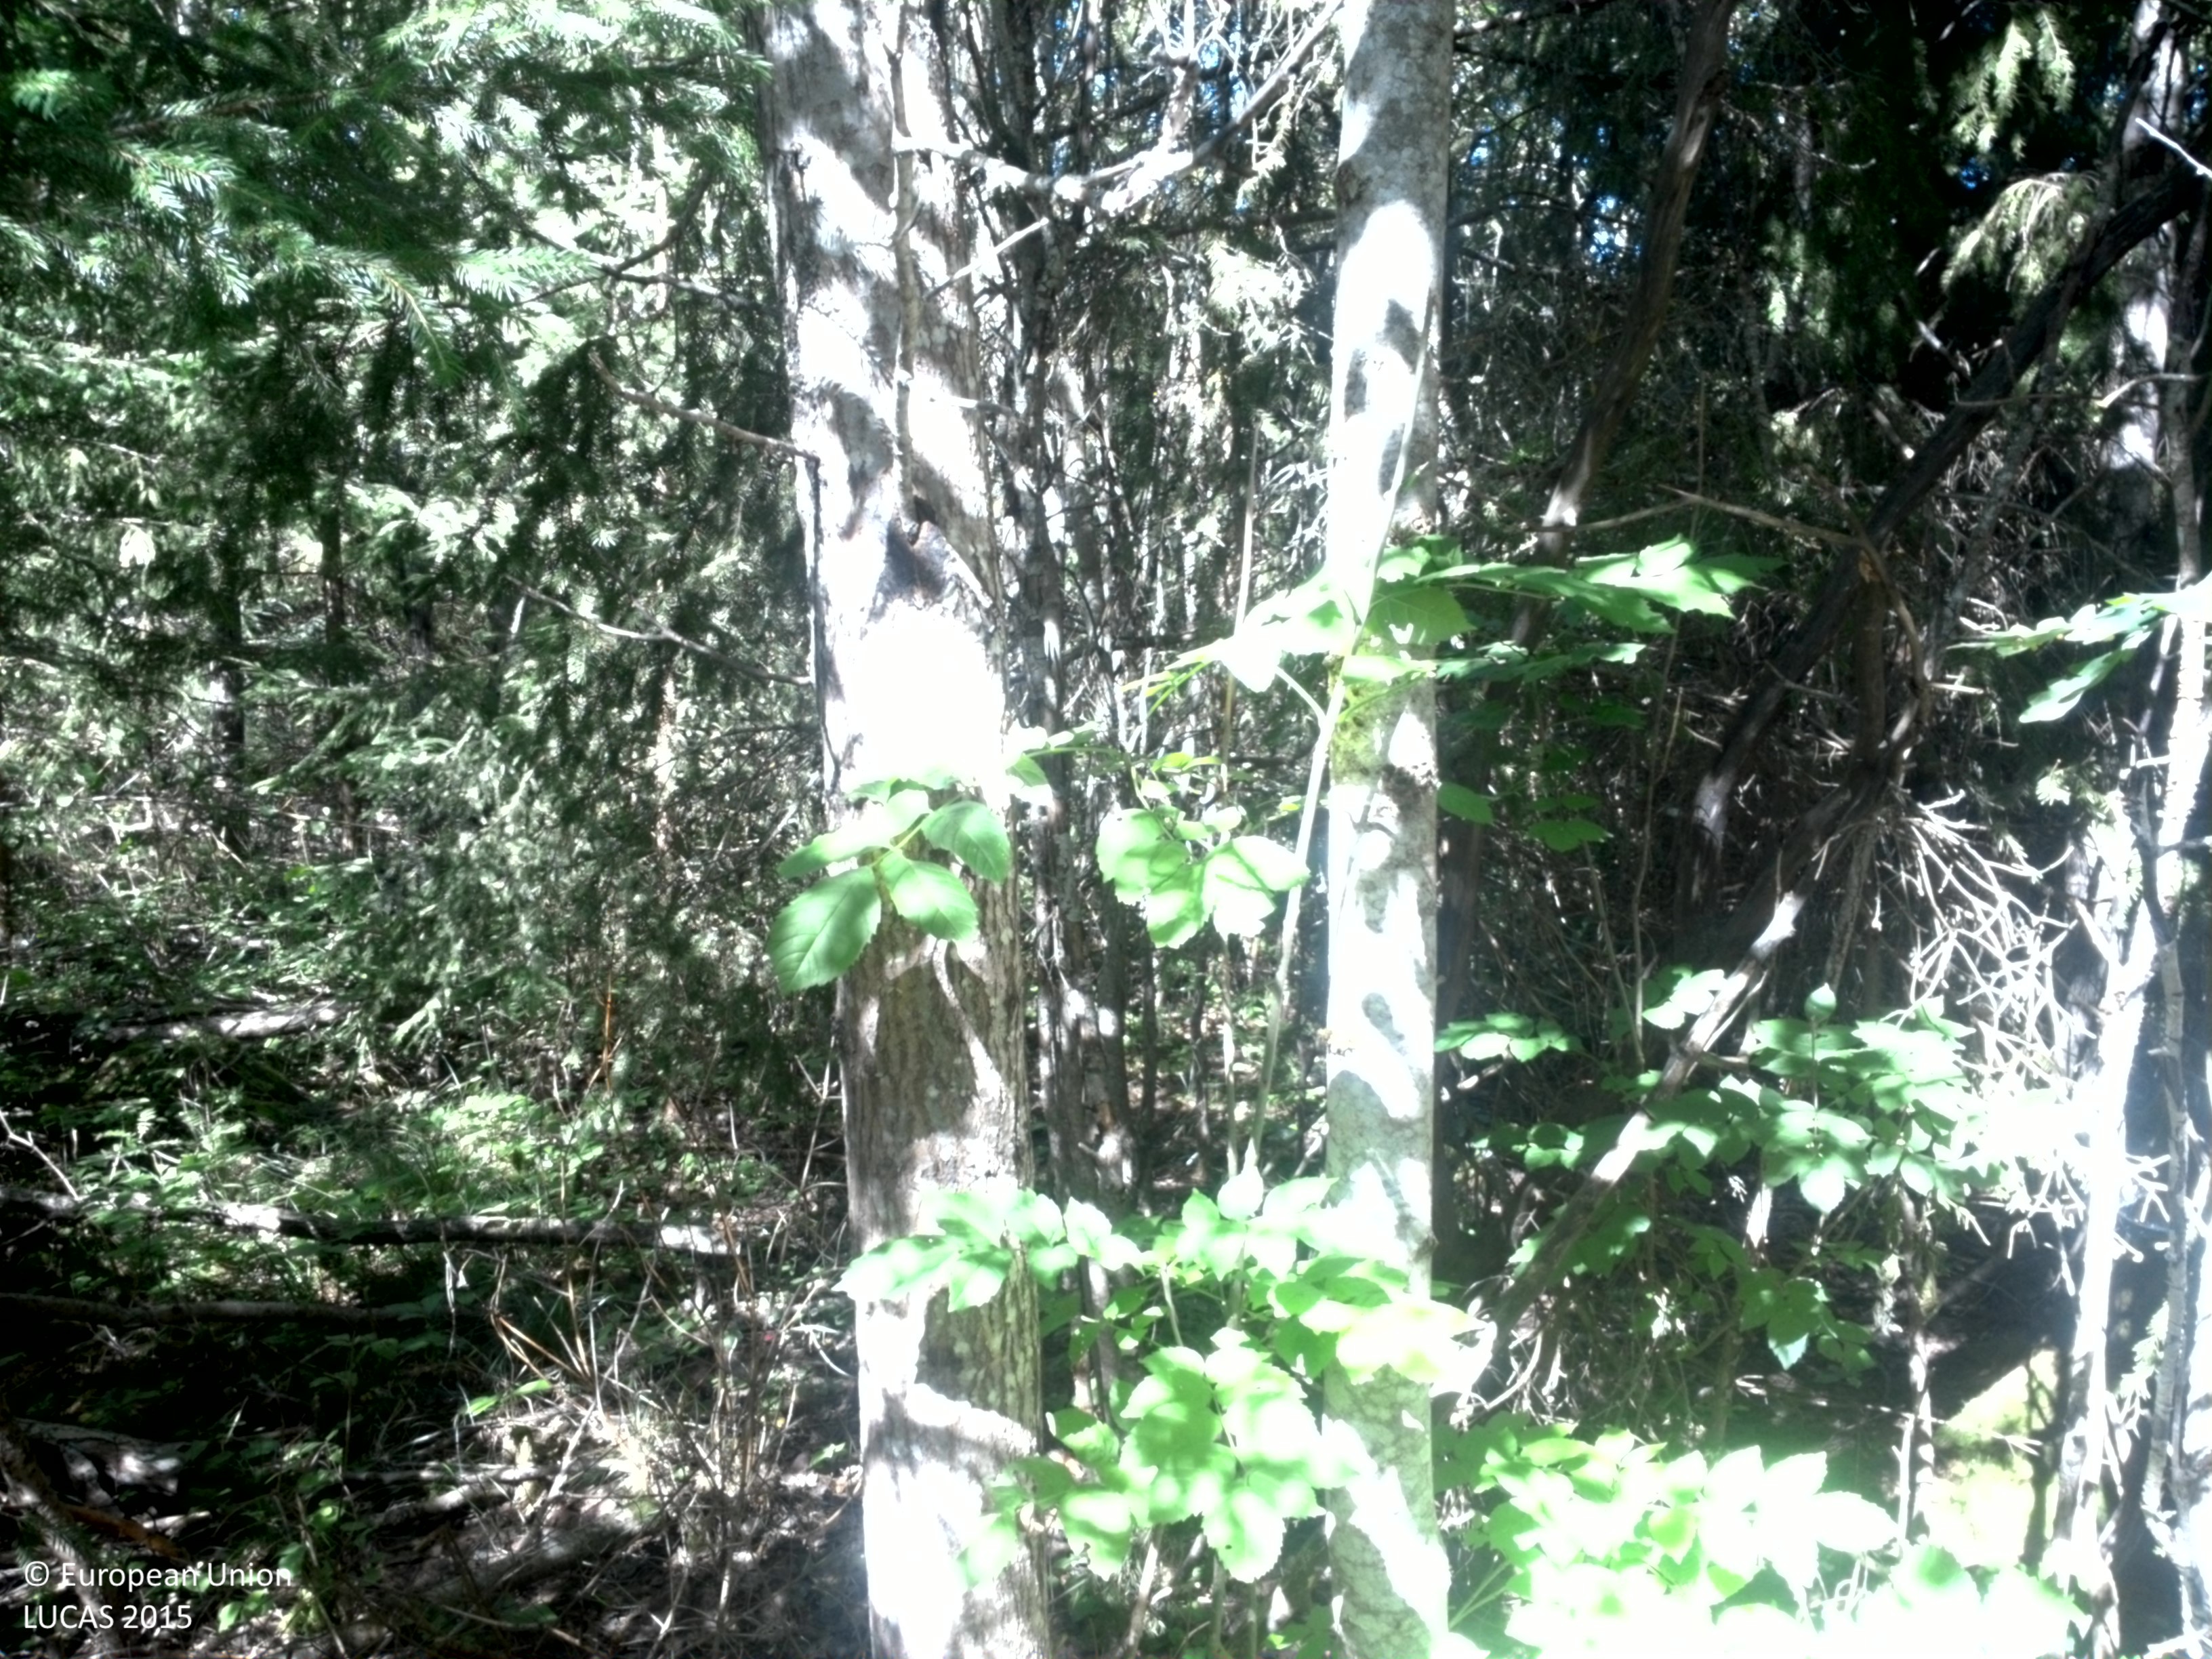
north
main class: Woodland
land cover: Spruce dominated coniferous woodland
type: boreal forest
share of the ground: > 75 %
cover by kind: coniferous forest trees 75 %, herbaceous plants 15 %, broadleaved forest trees 10 %
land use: Forestry
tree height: > 5 m
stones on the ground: 10 - 25 %
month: August
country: SE
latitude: 59.7268
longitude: 17.5170
